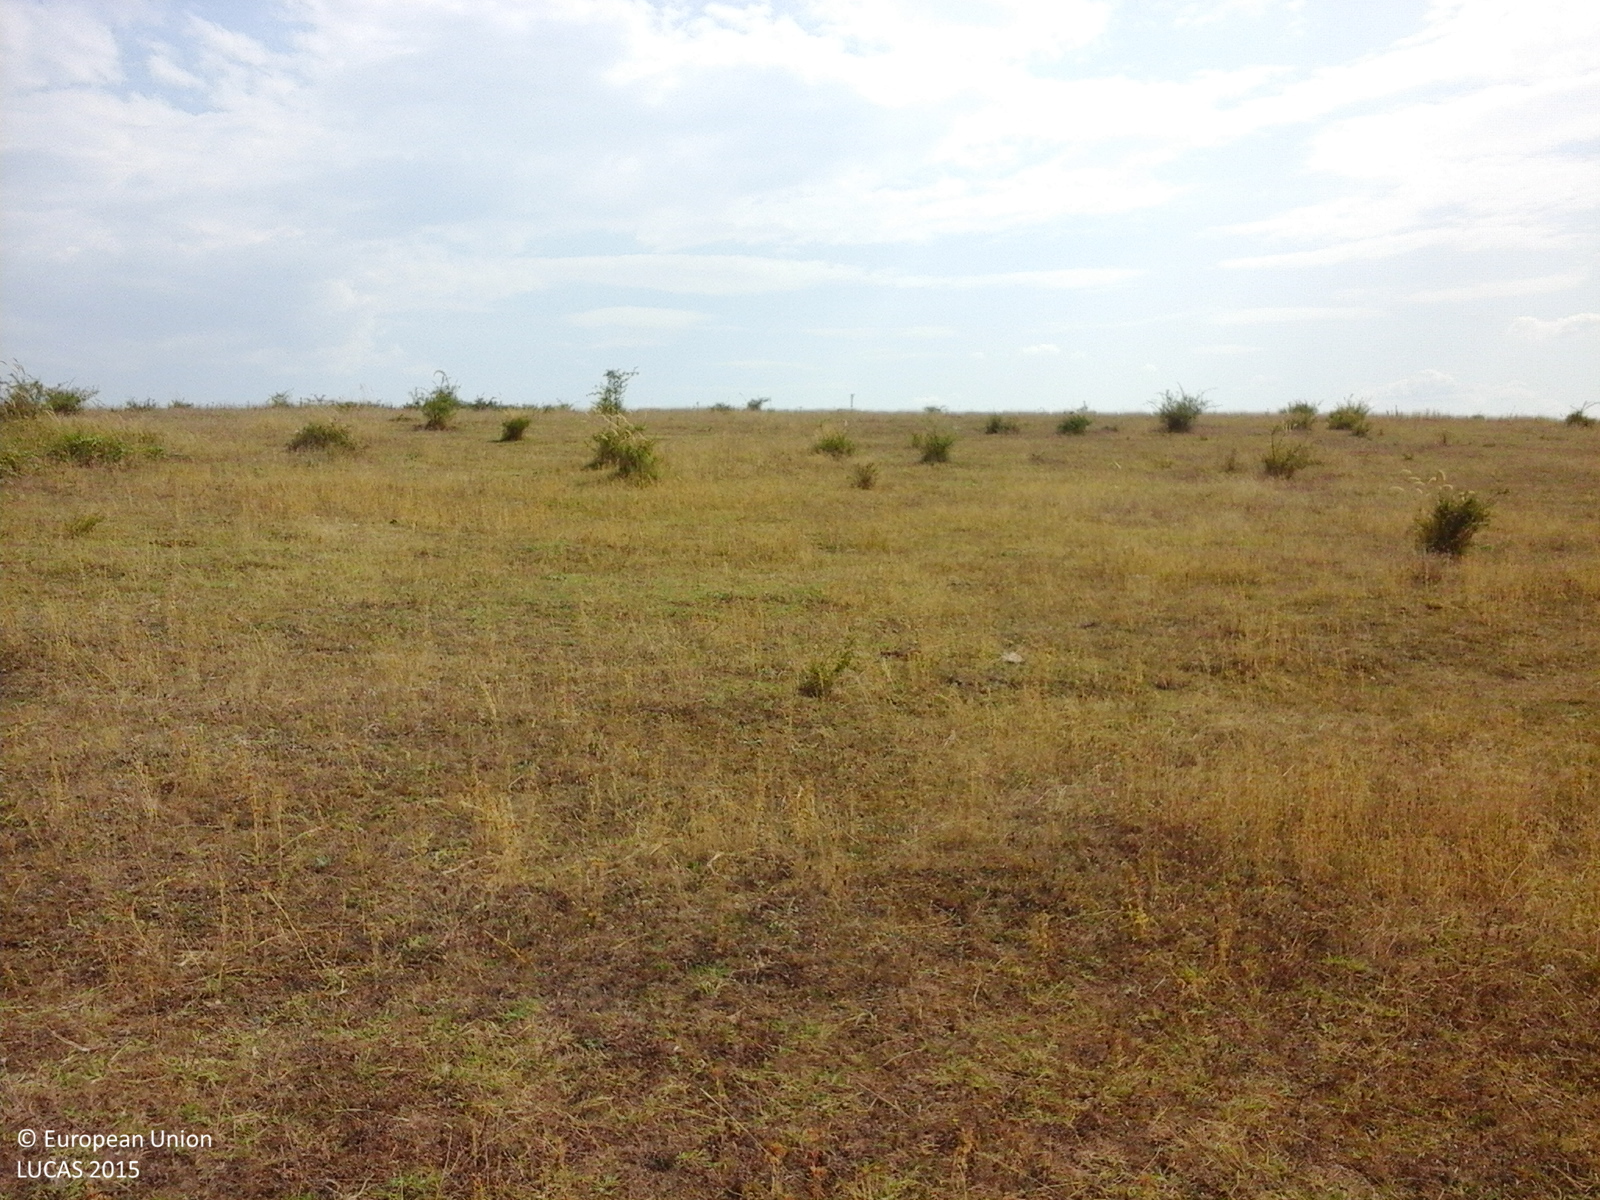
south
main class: Grassland
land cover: Grassland with sparse tree/shrub cover
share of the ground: > 75 %
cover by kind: herbaceous plants 85 %, shrubs 10 %, broadleaved forest trees 5 %
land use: Agriculture (excluding fallow land and kitchen gardens)
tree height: < 5 m
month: August
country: RO
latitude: 44.6223
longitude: 23.5790
